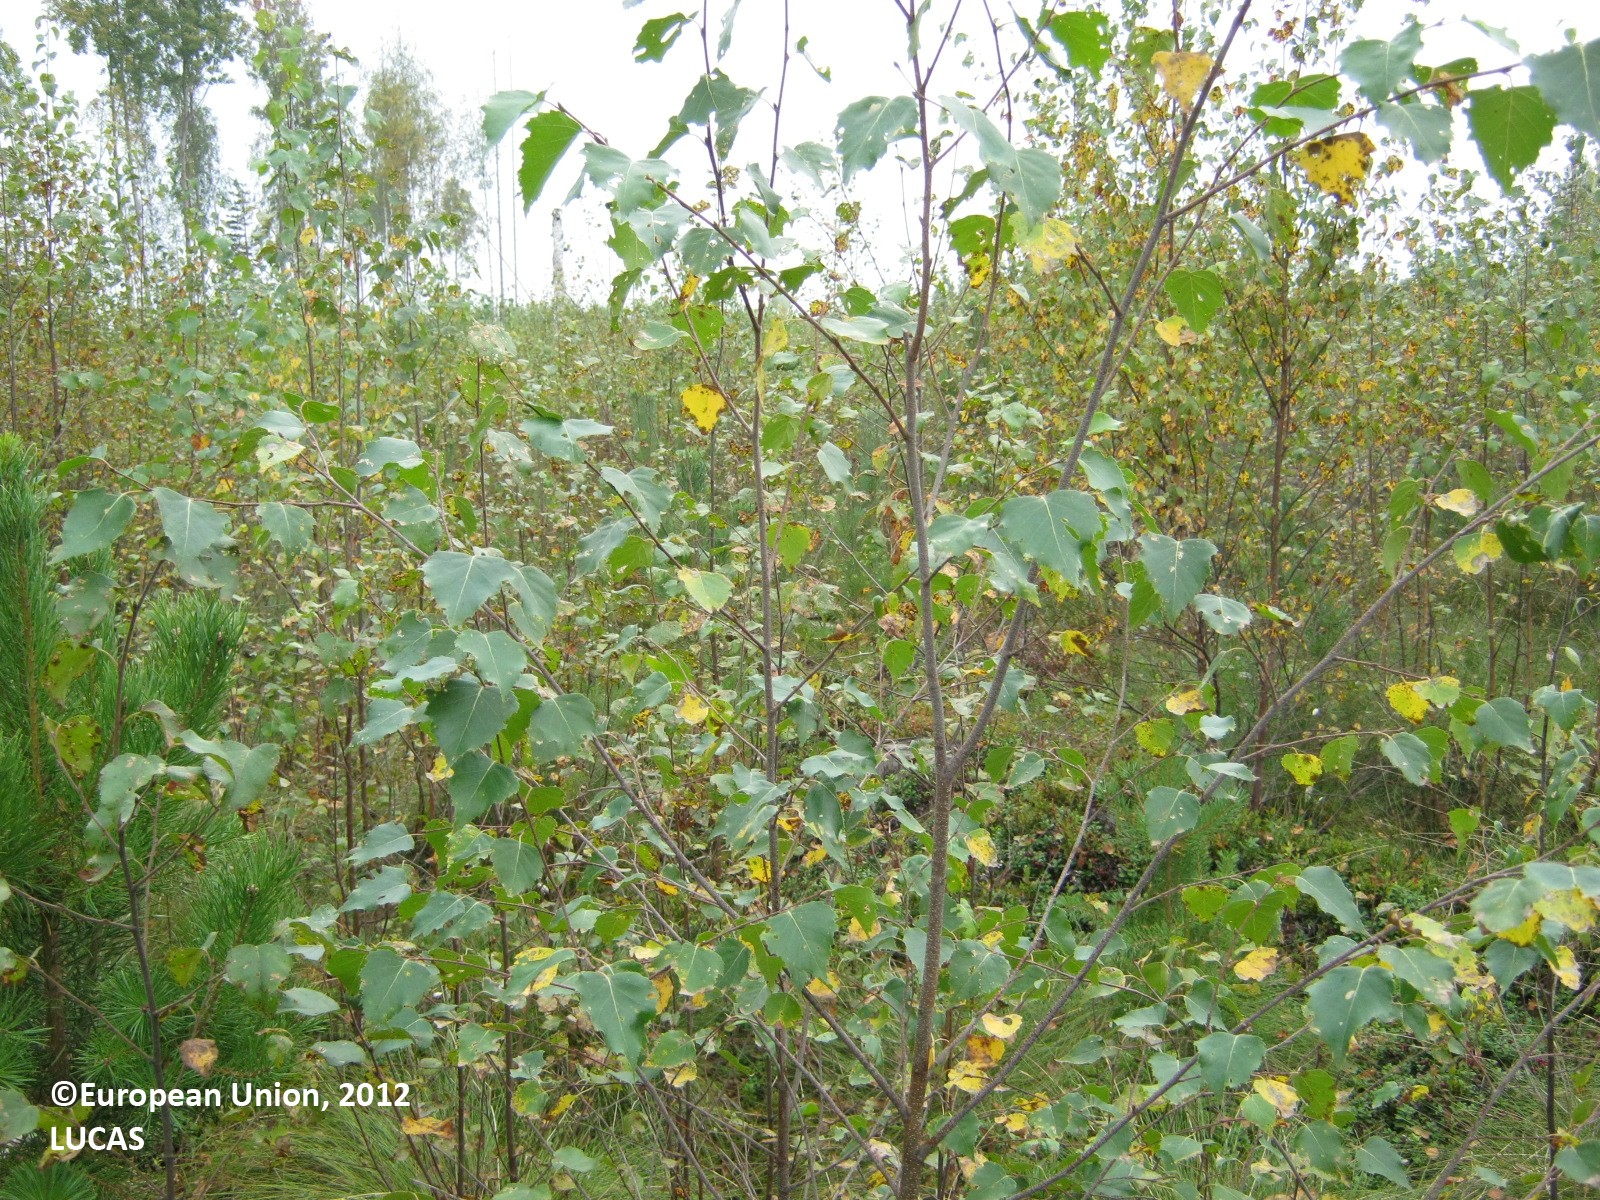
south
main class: Woodland
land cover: Broadleaved woodland
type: boreal forest
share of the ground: > 75 %
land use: Forestry
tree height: < 5 m
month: September
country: FI
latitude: 60.6592
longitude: 27.5491
